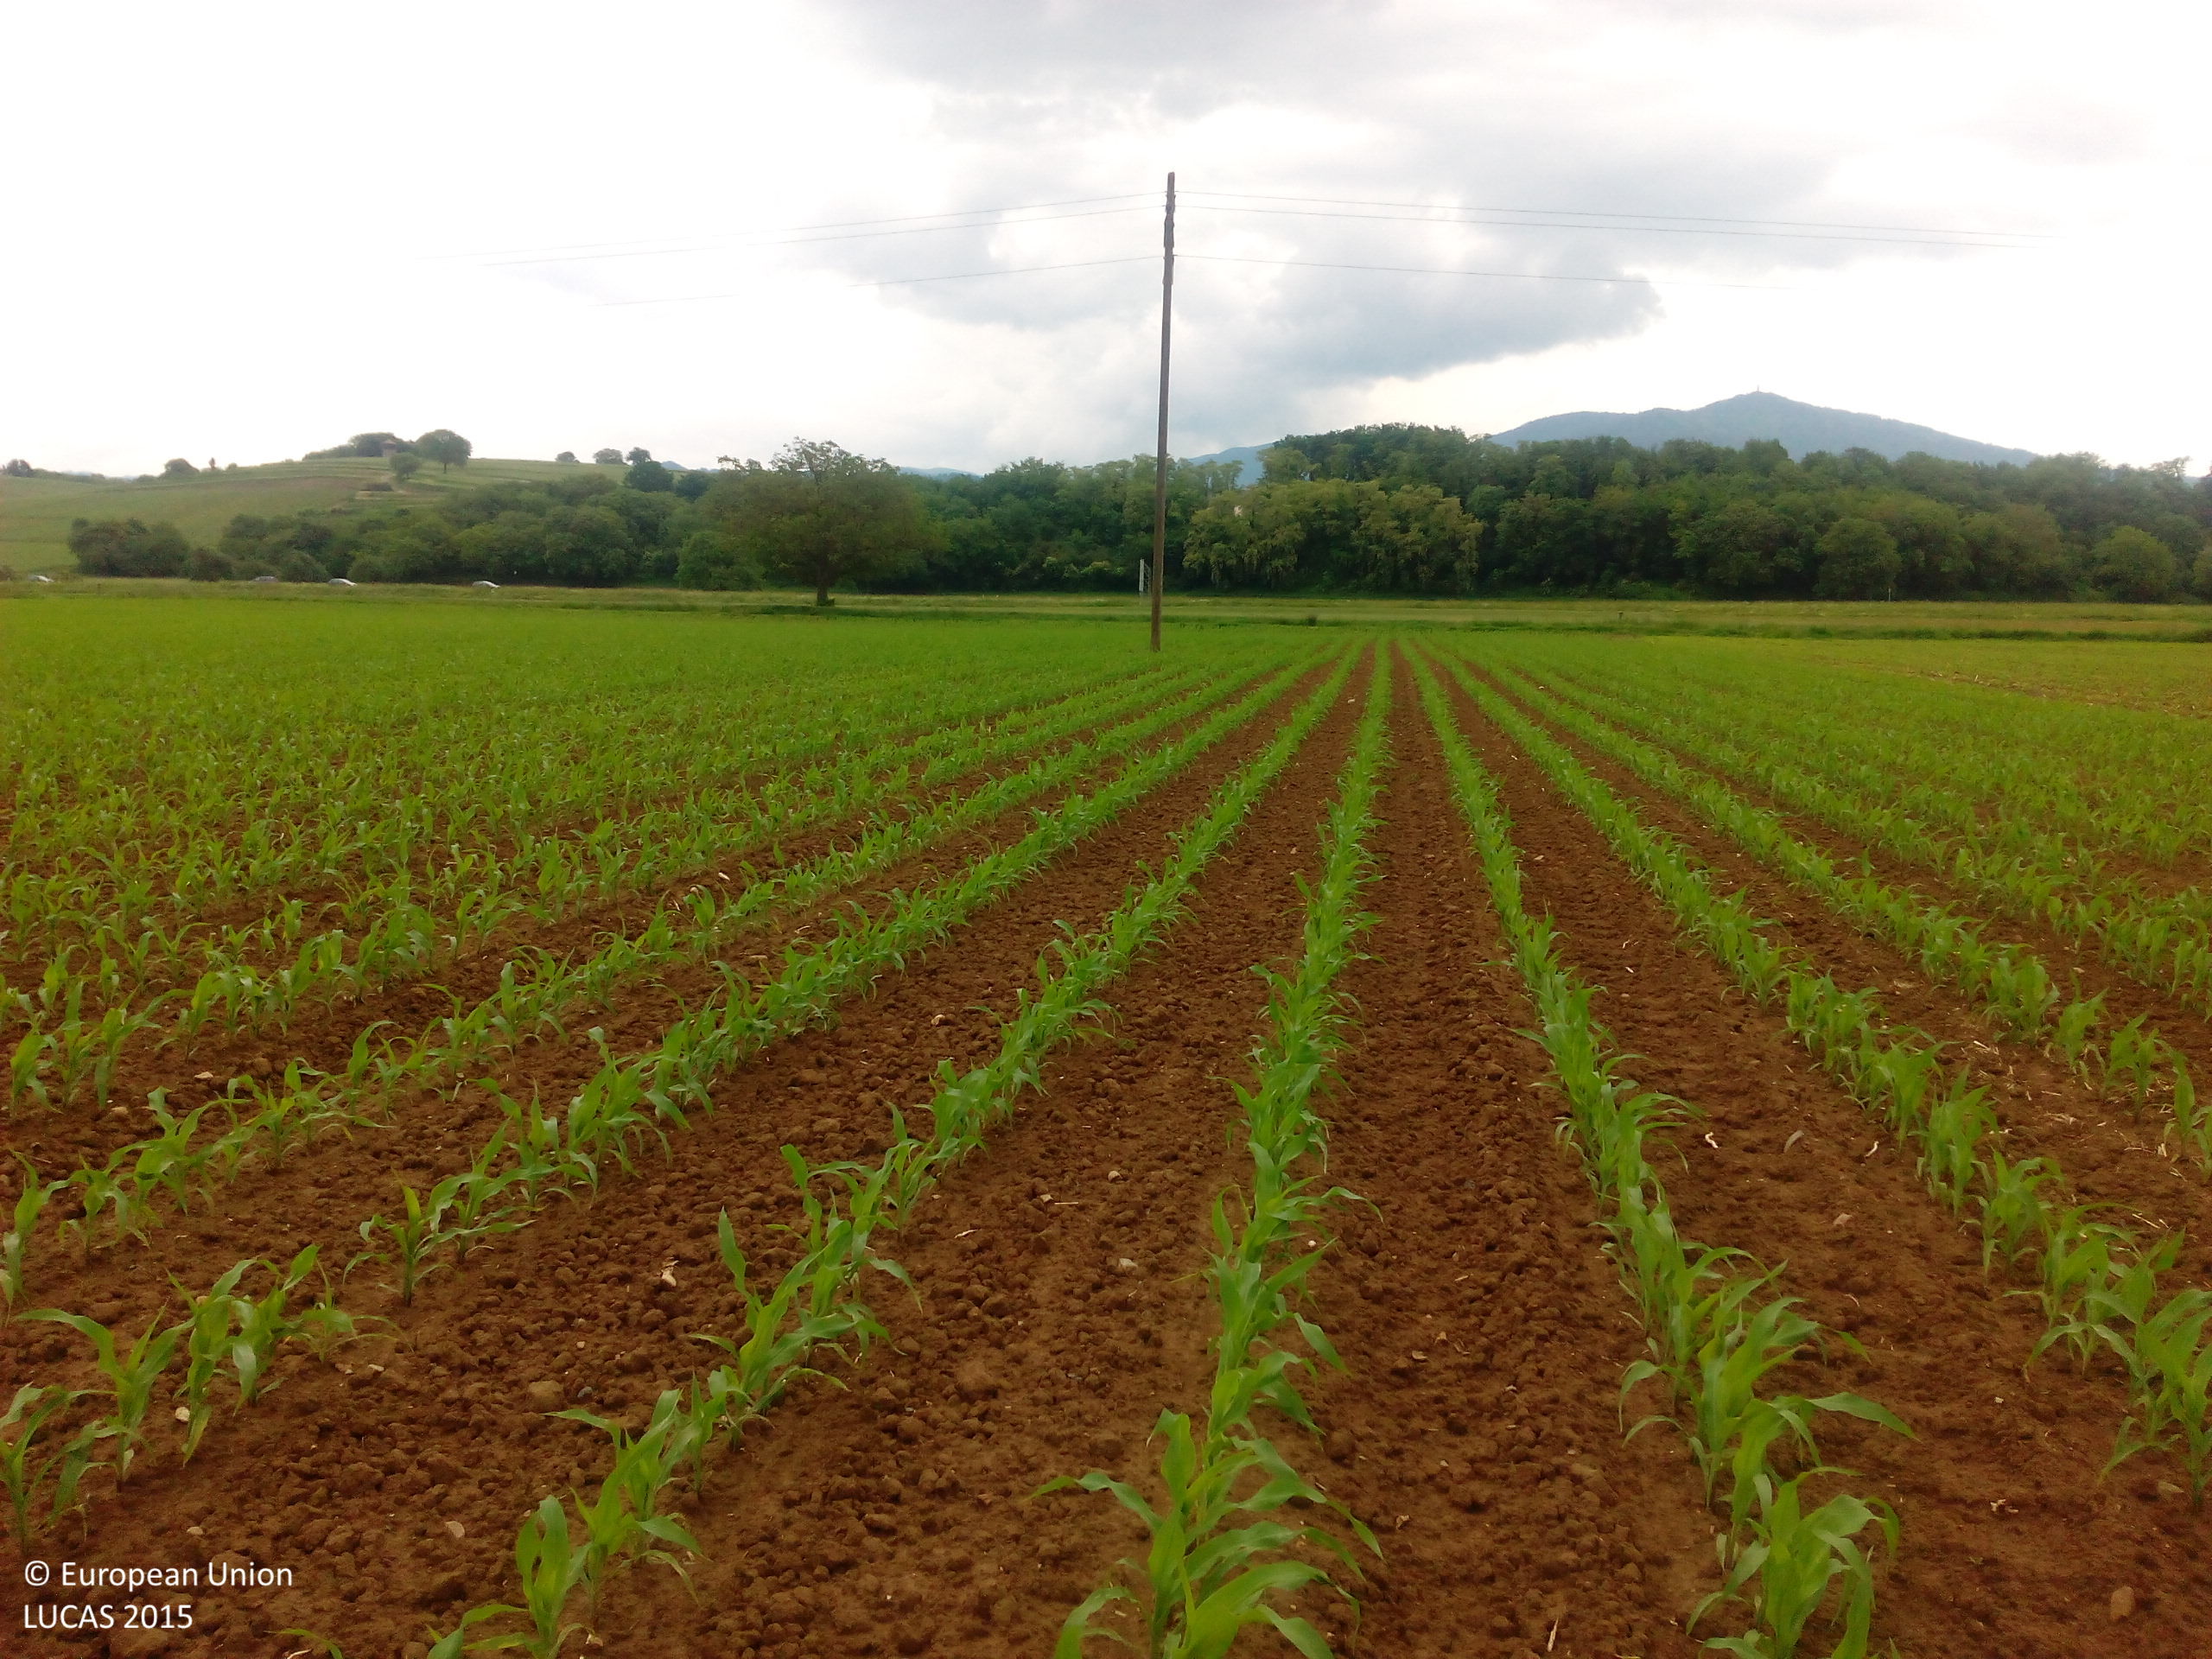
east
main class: Cropland
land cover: Maize
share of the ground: 25 - 50 %
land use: Agriculture (excluding fallow land and kitchen gardens)
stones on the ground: < 10 %
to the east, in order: Maize; Electric lines; Maize; Tracks; Single bushes/trees; Common wheat; Paved roads, cycling and walking lanes; Grassland without tree/shrub cover
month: May
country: DE
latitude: 47.8196
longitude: 7.6106
